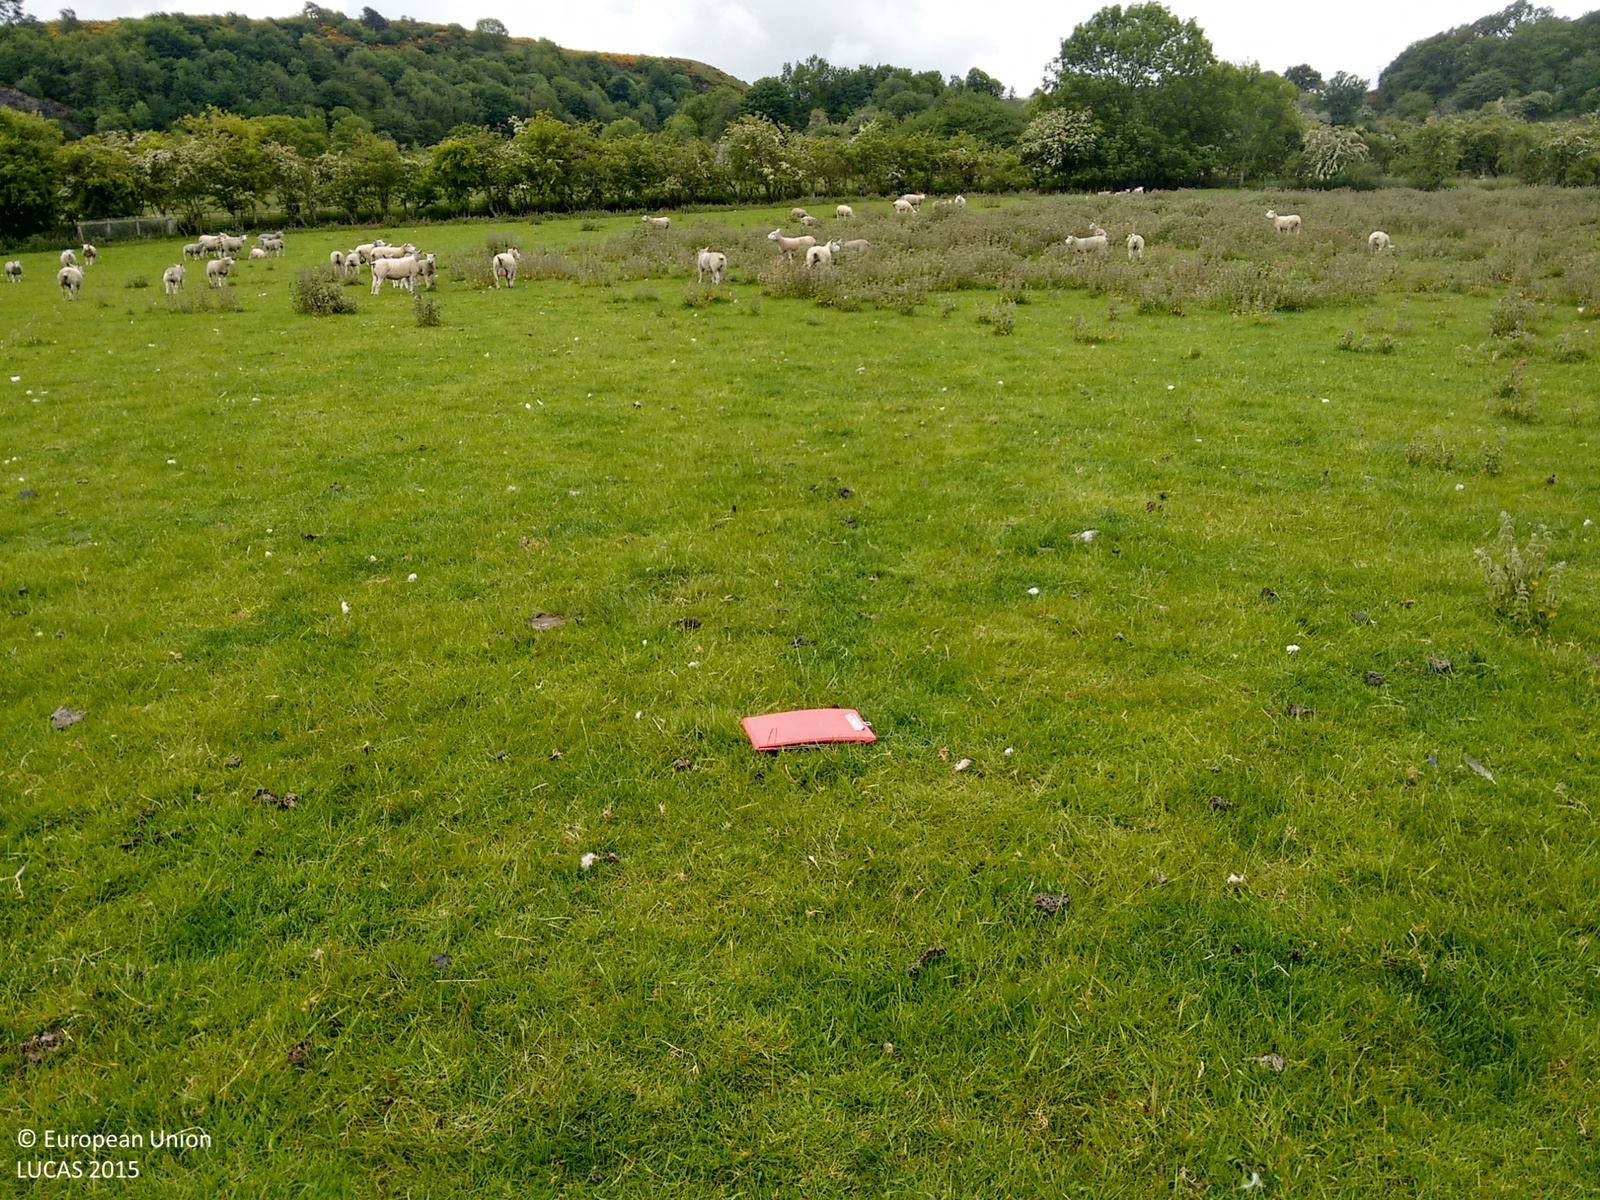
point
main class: Grassland
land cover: Grassland without tree/shrub cover
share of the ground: > 75 %
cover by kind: herbaceous plants 100 %
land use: Agriculture (excluding fallow land and kitchen gardens)
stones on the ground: < 10 %
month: June
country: GB
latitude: 56.3291
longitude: -3.3177
